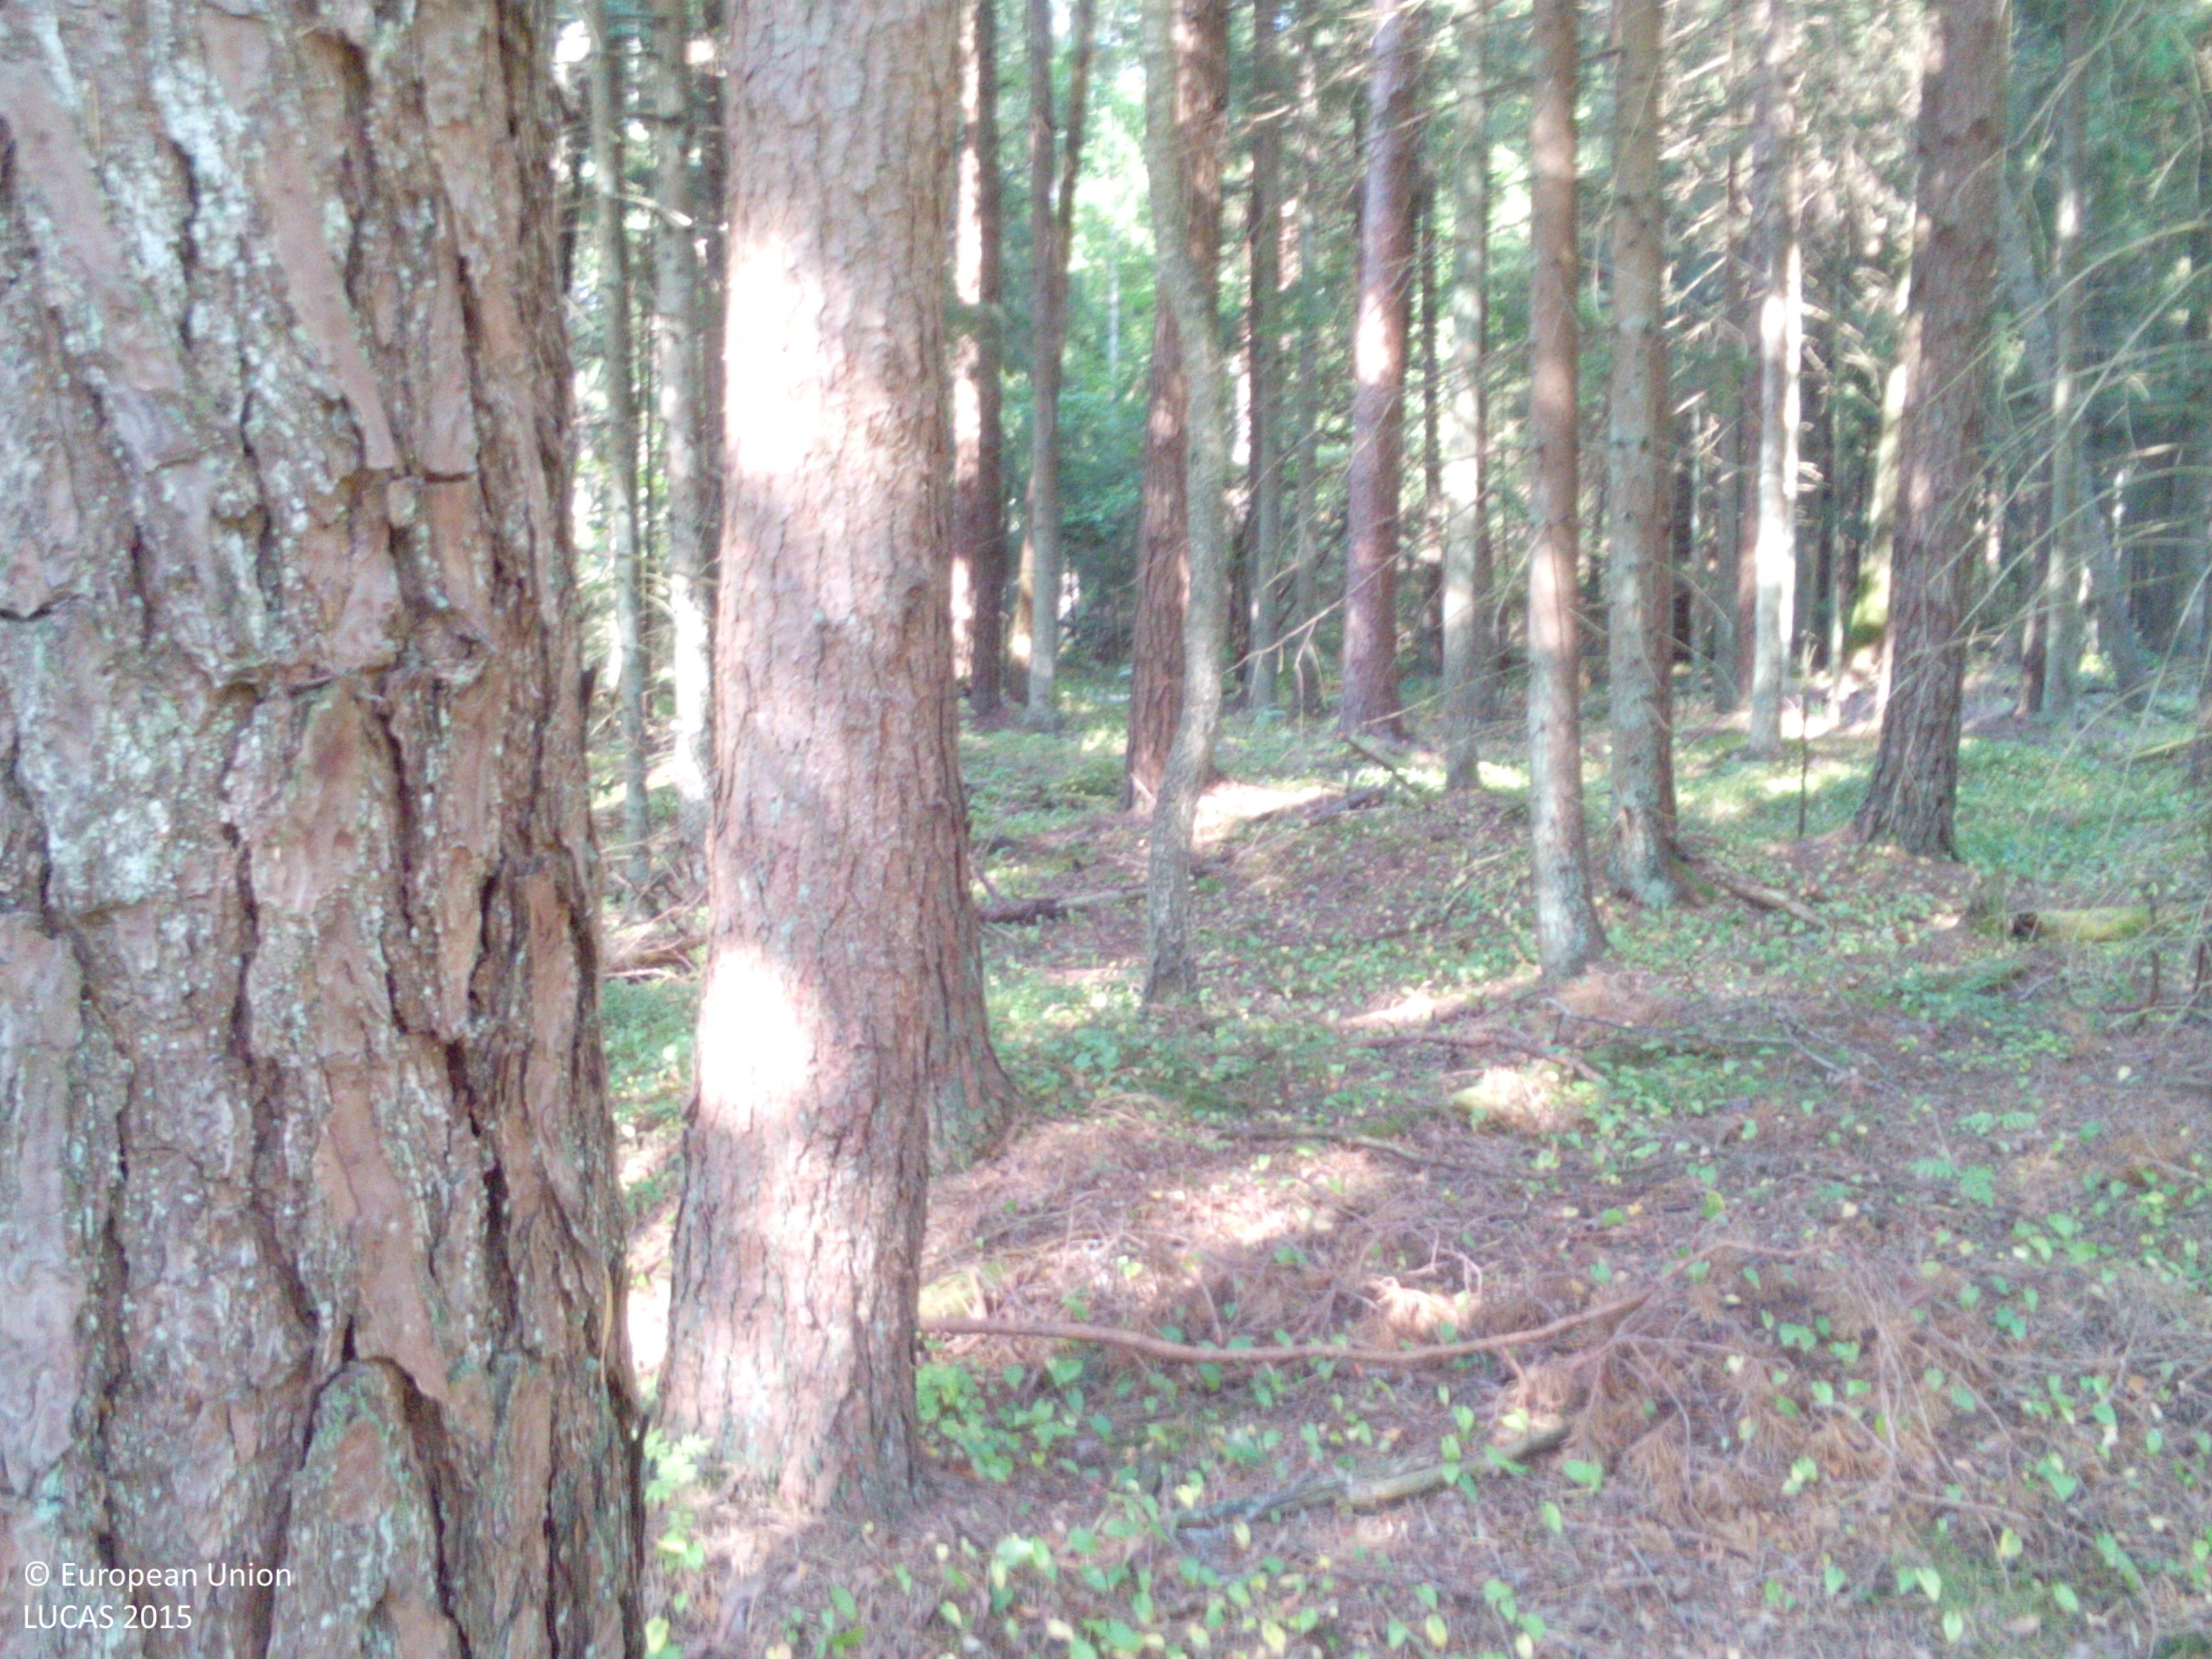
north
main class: Woodland
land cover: Other coniferous woodland
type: hemiboreal forest and nemoral coniferous forest and mixed broadleaved-coniferous forest
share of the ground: > 75 %
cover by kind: coniferous forest trees 85 %, herbaceous plants 10 %, unconsolidated bare surface 5 %
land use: Forestry
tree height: > 5 m
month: August
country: LV
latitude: 56.3659
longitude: 21.2251
